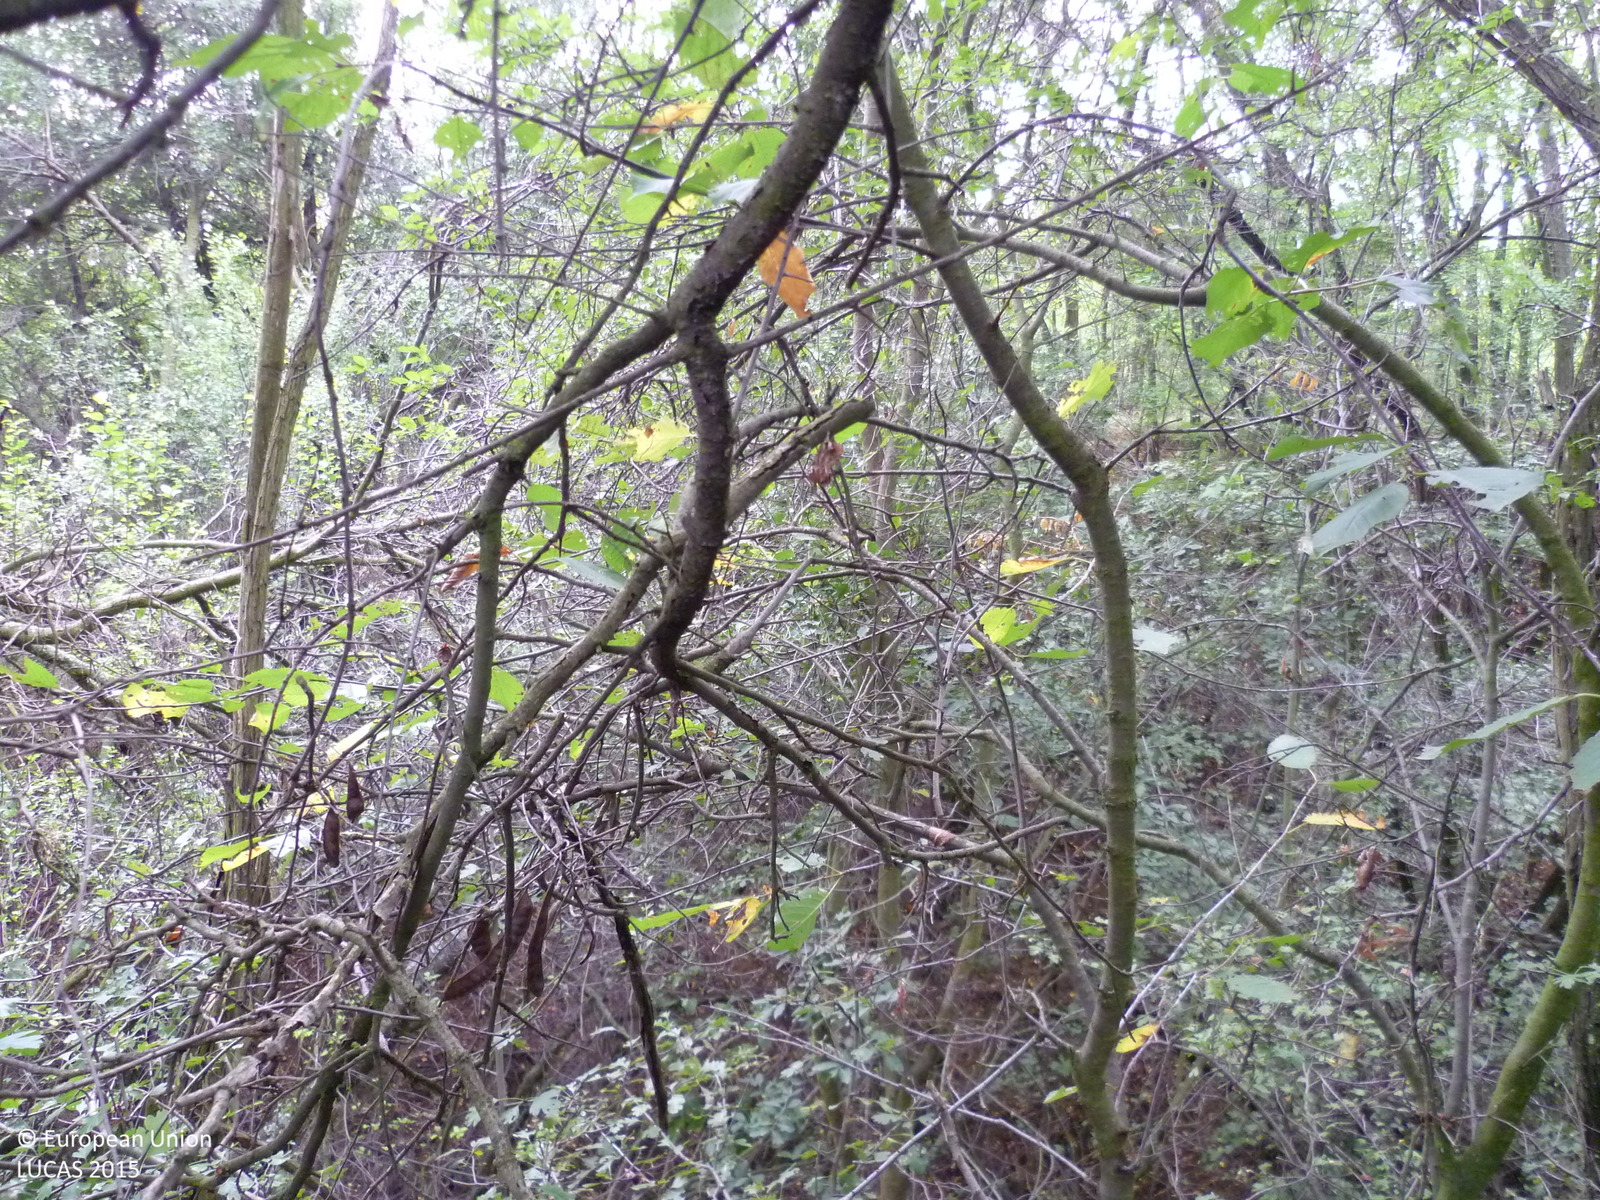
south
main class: Woodland
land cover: Broadleaved woodland
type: mesophytic deciduous forest
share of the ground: > 75 %
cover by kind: broadleaved forest trees 80 %, unconsolidated bare surface 15 %, lichens and mosses 5 %
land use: Semi-natural and natural areas not in use
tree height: > 5 m
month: September
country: BG
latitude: 42.8681
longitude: 23.1679
